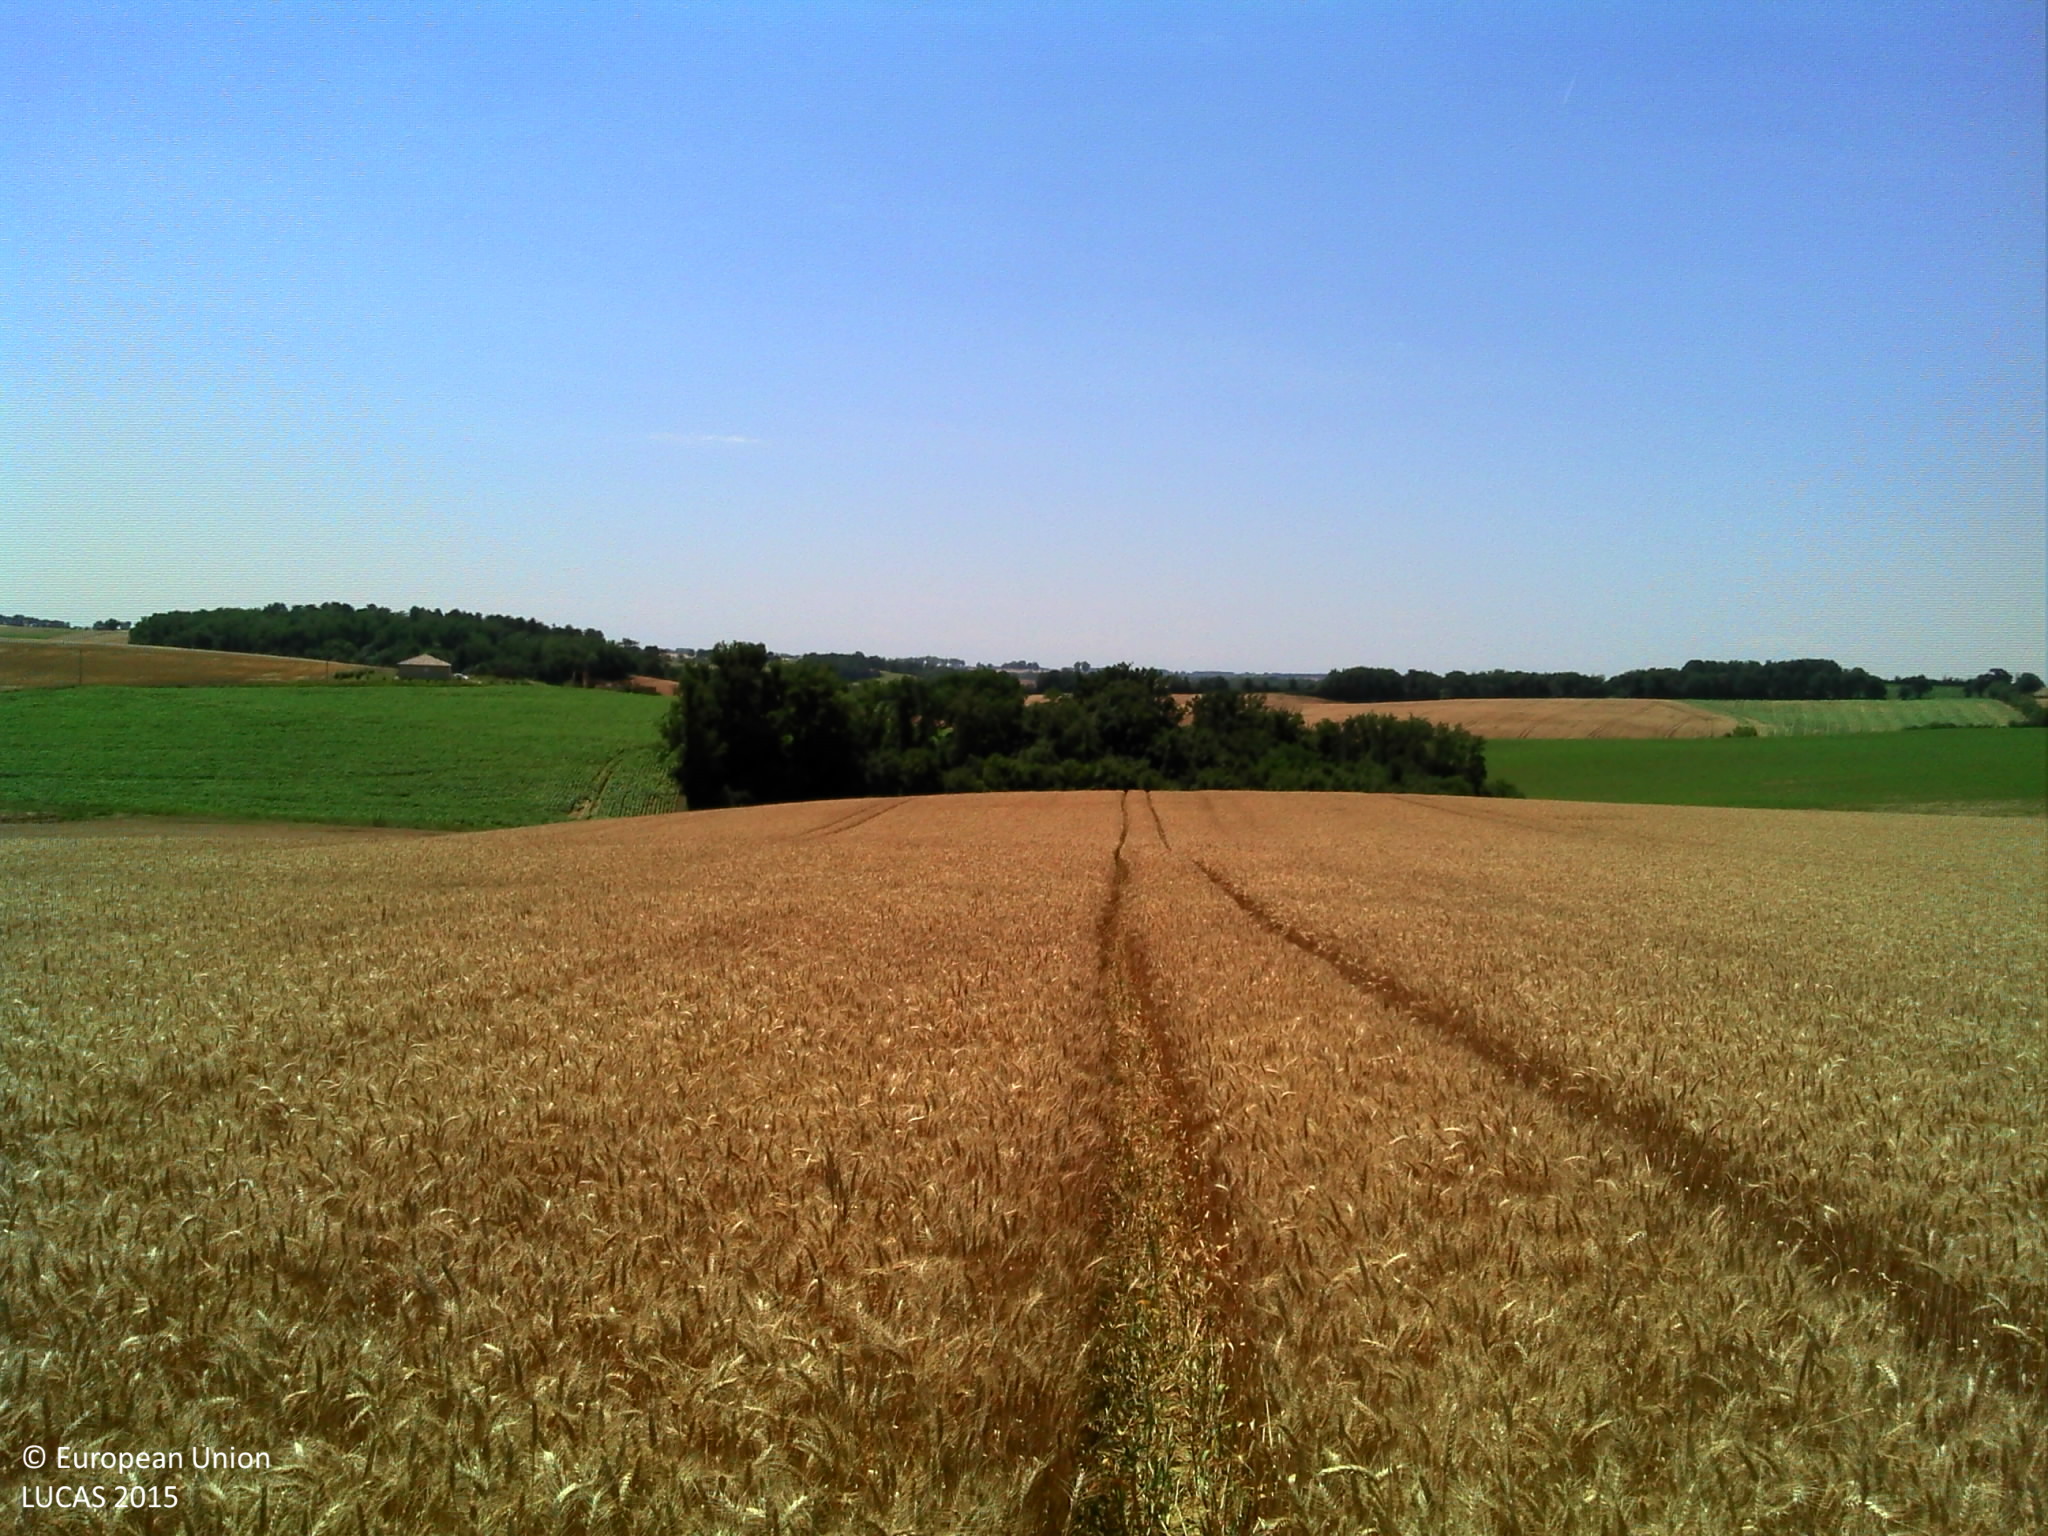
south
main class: Cropland
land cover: Common wheat
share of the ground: > 75 %
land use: Agriculture (excluding fallow land and kitchen gardens)
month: June
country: FR
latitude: 43.7745
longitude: 0.9670
